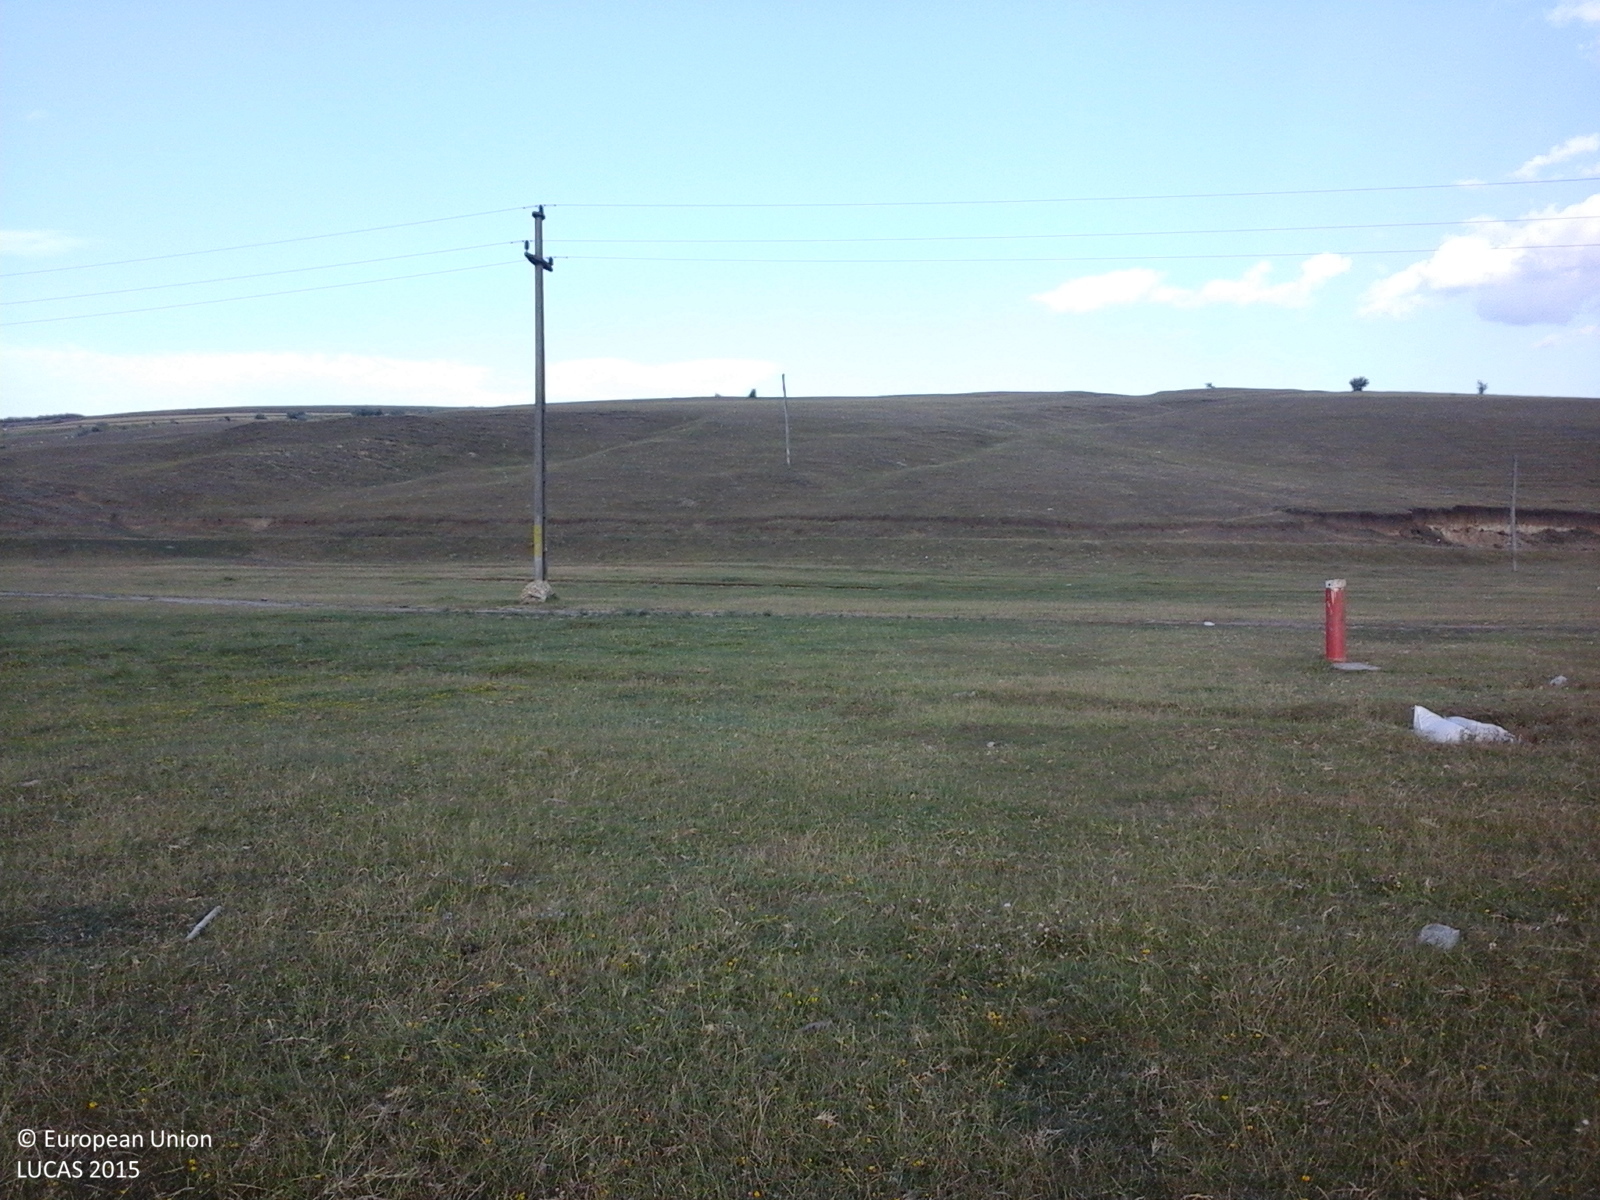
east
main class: Grassland
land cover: Grassland without tree/shrub cover
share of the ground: > 75 %
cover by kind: herbaceous plants 100 %
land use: Agriculture (excluding fallow land and kitchen gardens)
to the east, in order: Grassland without tree/shrub cover; Electric lines; Grassland without tree/shrub cover; Tracks; Grassland without tree/shrub cover; Paved roads, cycling and walking lanes; Grassland without tree/shrub cover; Single bushes/trees; Grassland without tree/shrub cover
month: July
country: RO
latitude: 46.2647
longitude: 27.5613
